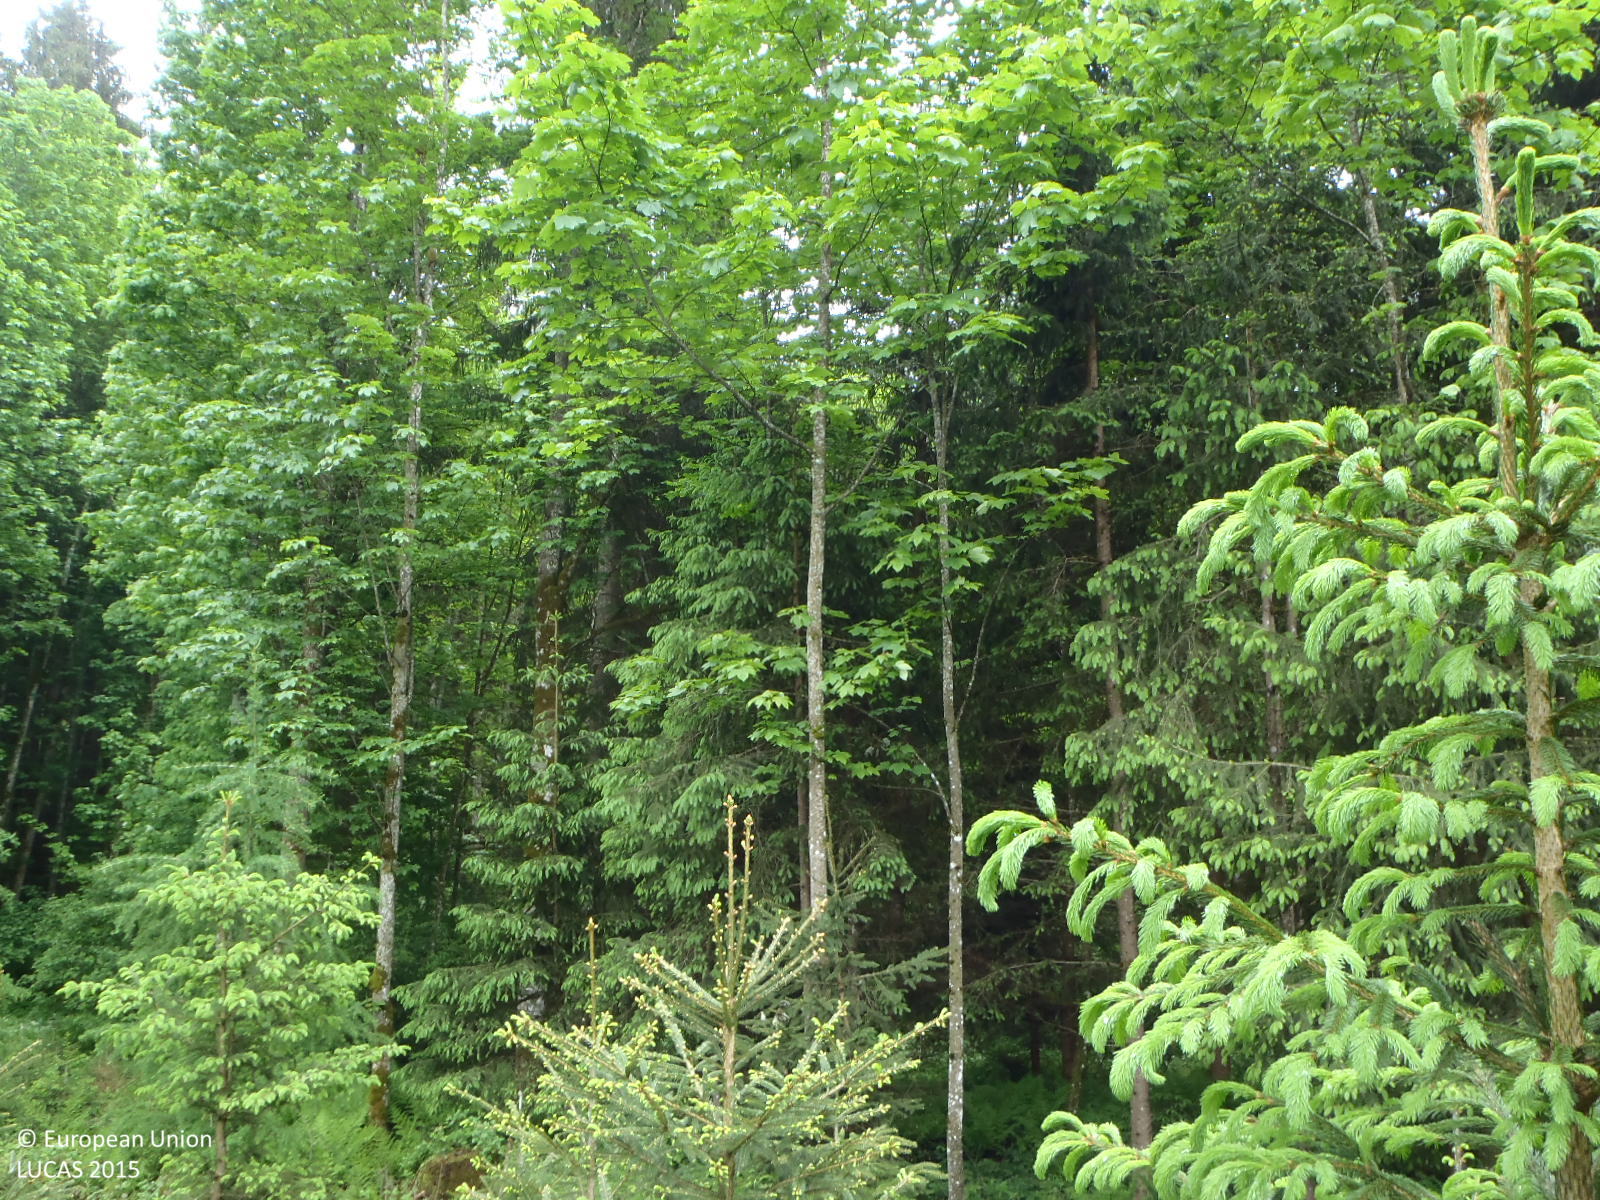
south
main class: Woodland
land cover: Other mixed woodland
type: alpine coniferous forest
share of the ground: > 75 %
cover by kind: coniferous forest trees 60 %, broadleaved forest trees 25 %, herbaceous plants 15 %
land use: Forestry
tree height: > 5 m
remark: Nursery
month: May
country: AT
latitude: 47.4124
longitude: 12.8476
